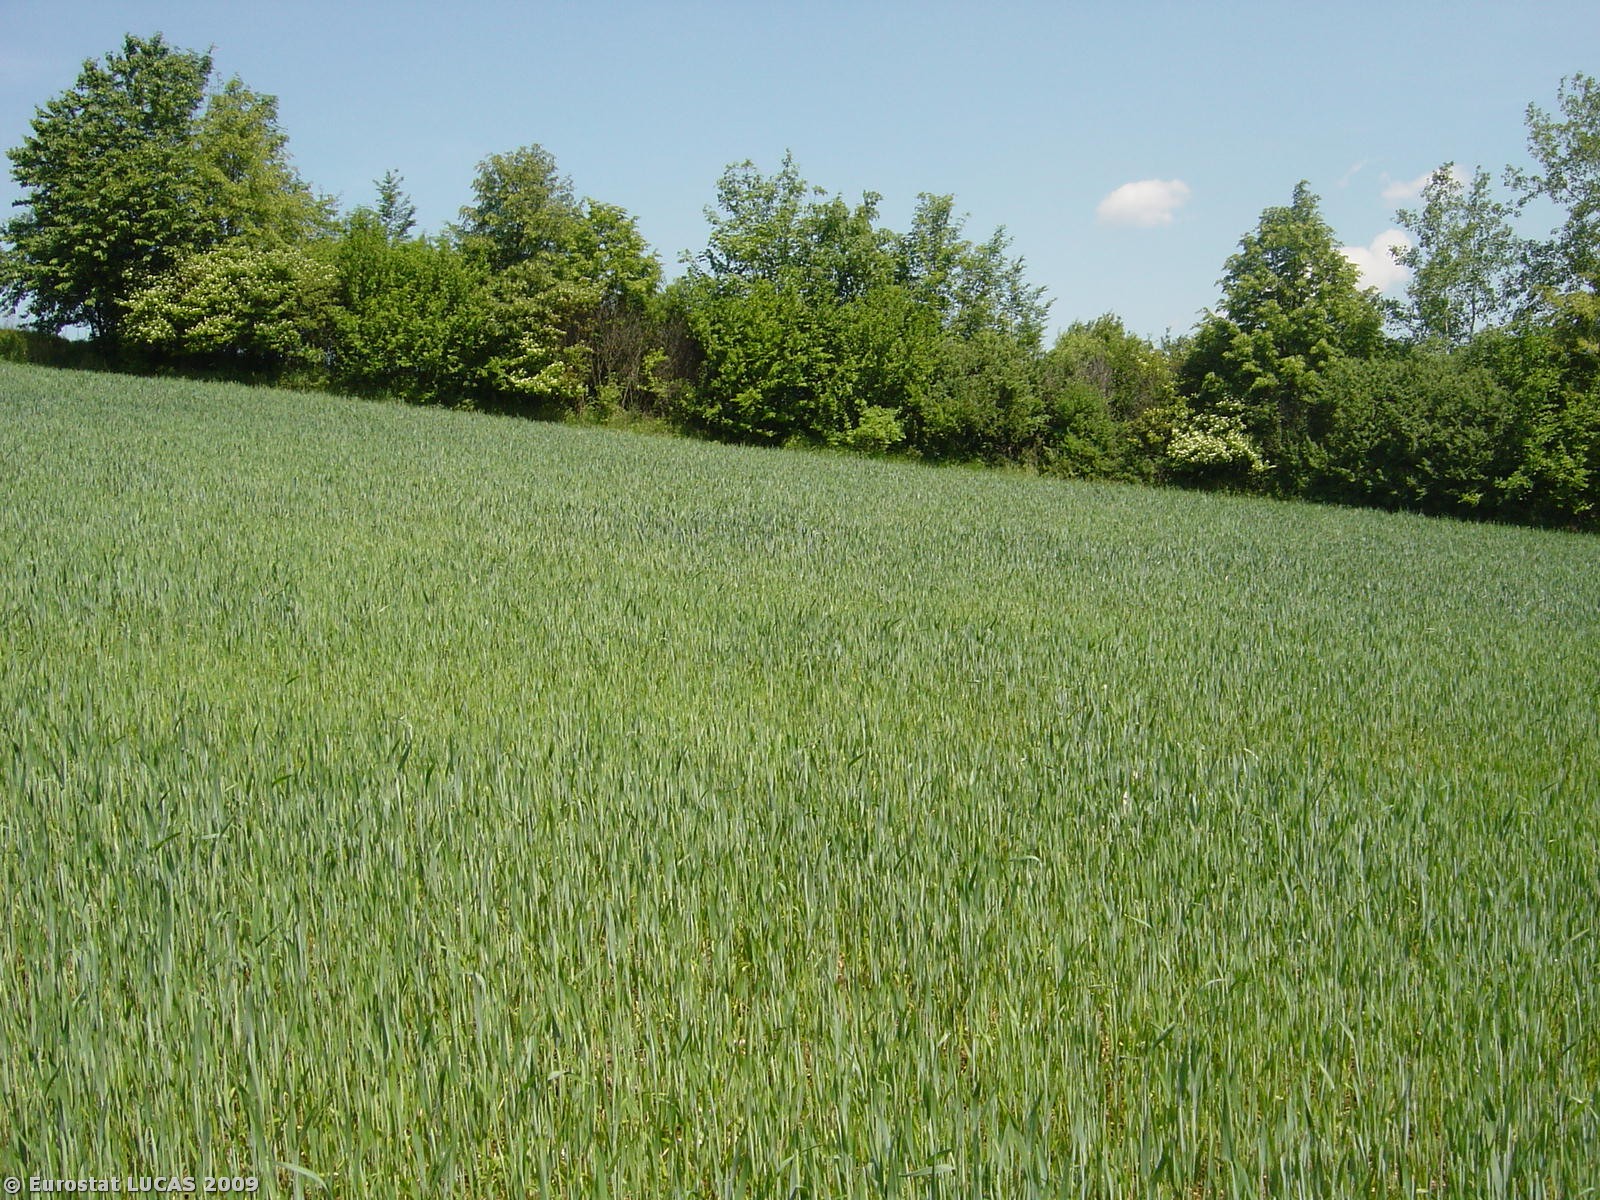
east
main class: Cropland
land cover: Common wheat
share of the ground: > 75 %
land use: Agriculture (excluding fallow land and kitchen gardens)
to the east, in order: Common wheat; Broadleaved woodland; Common wheat
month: May
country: CZ
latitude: 49.0414
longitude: 17.1095
